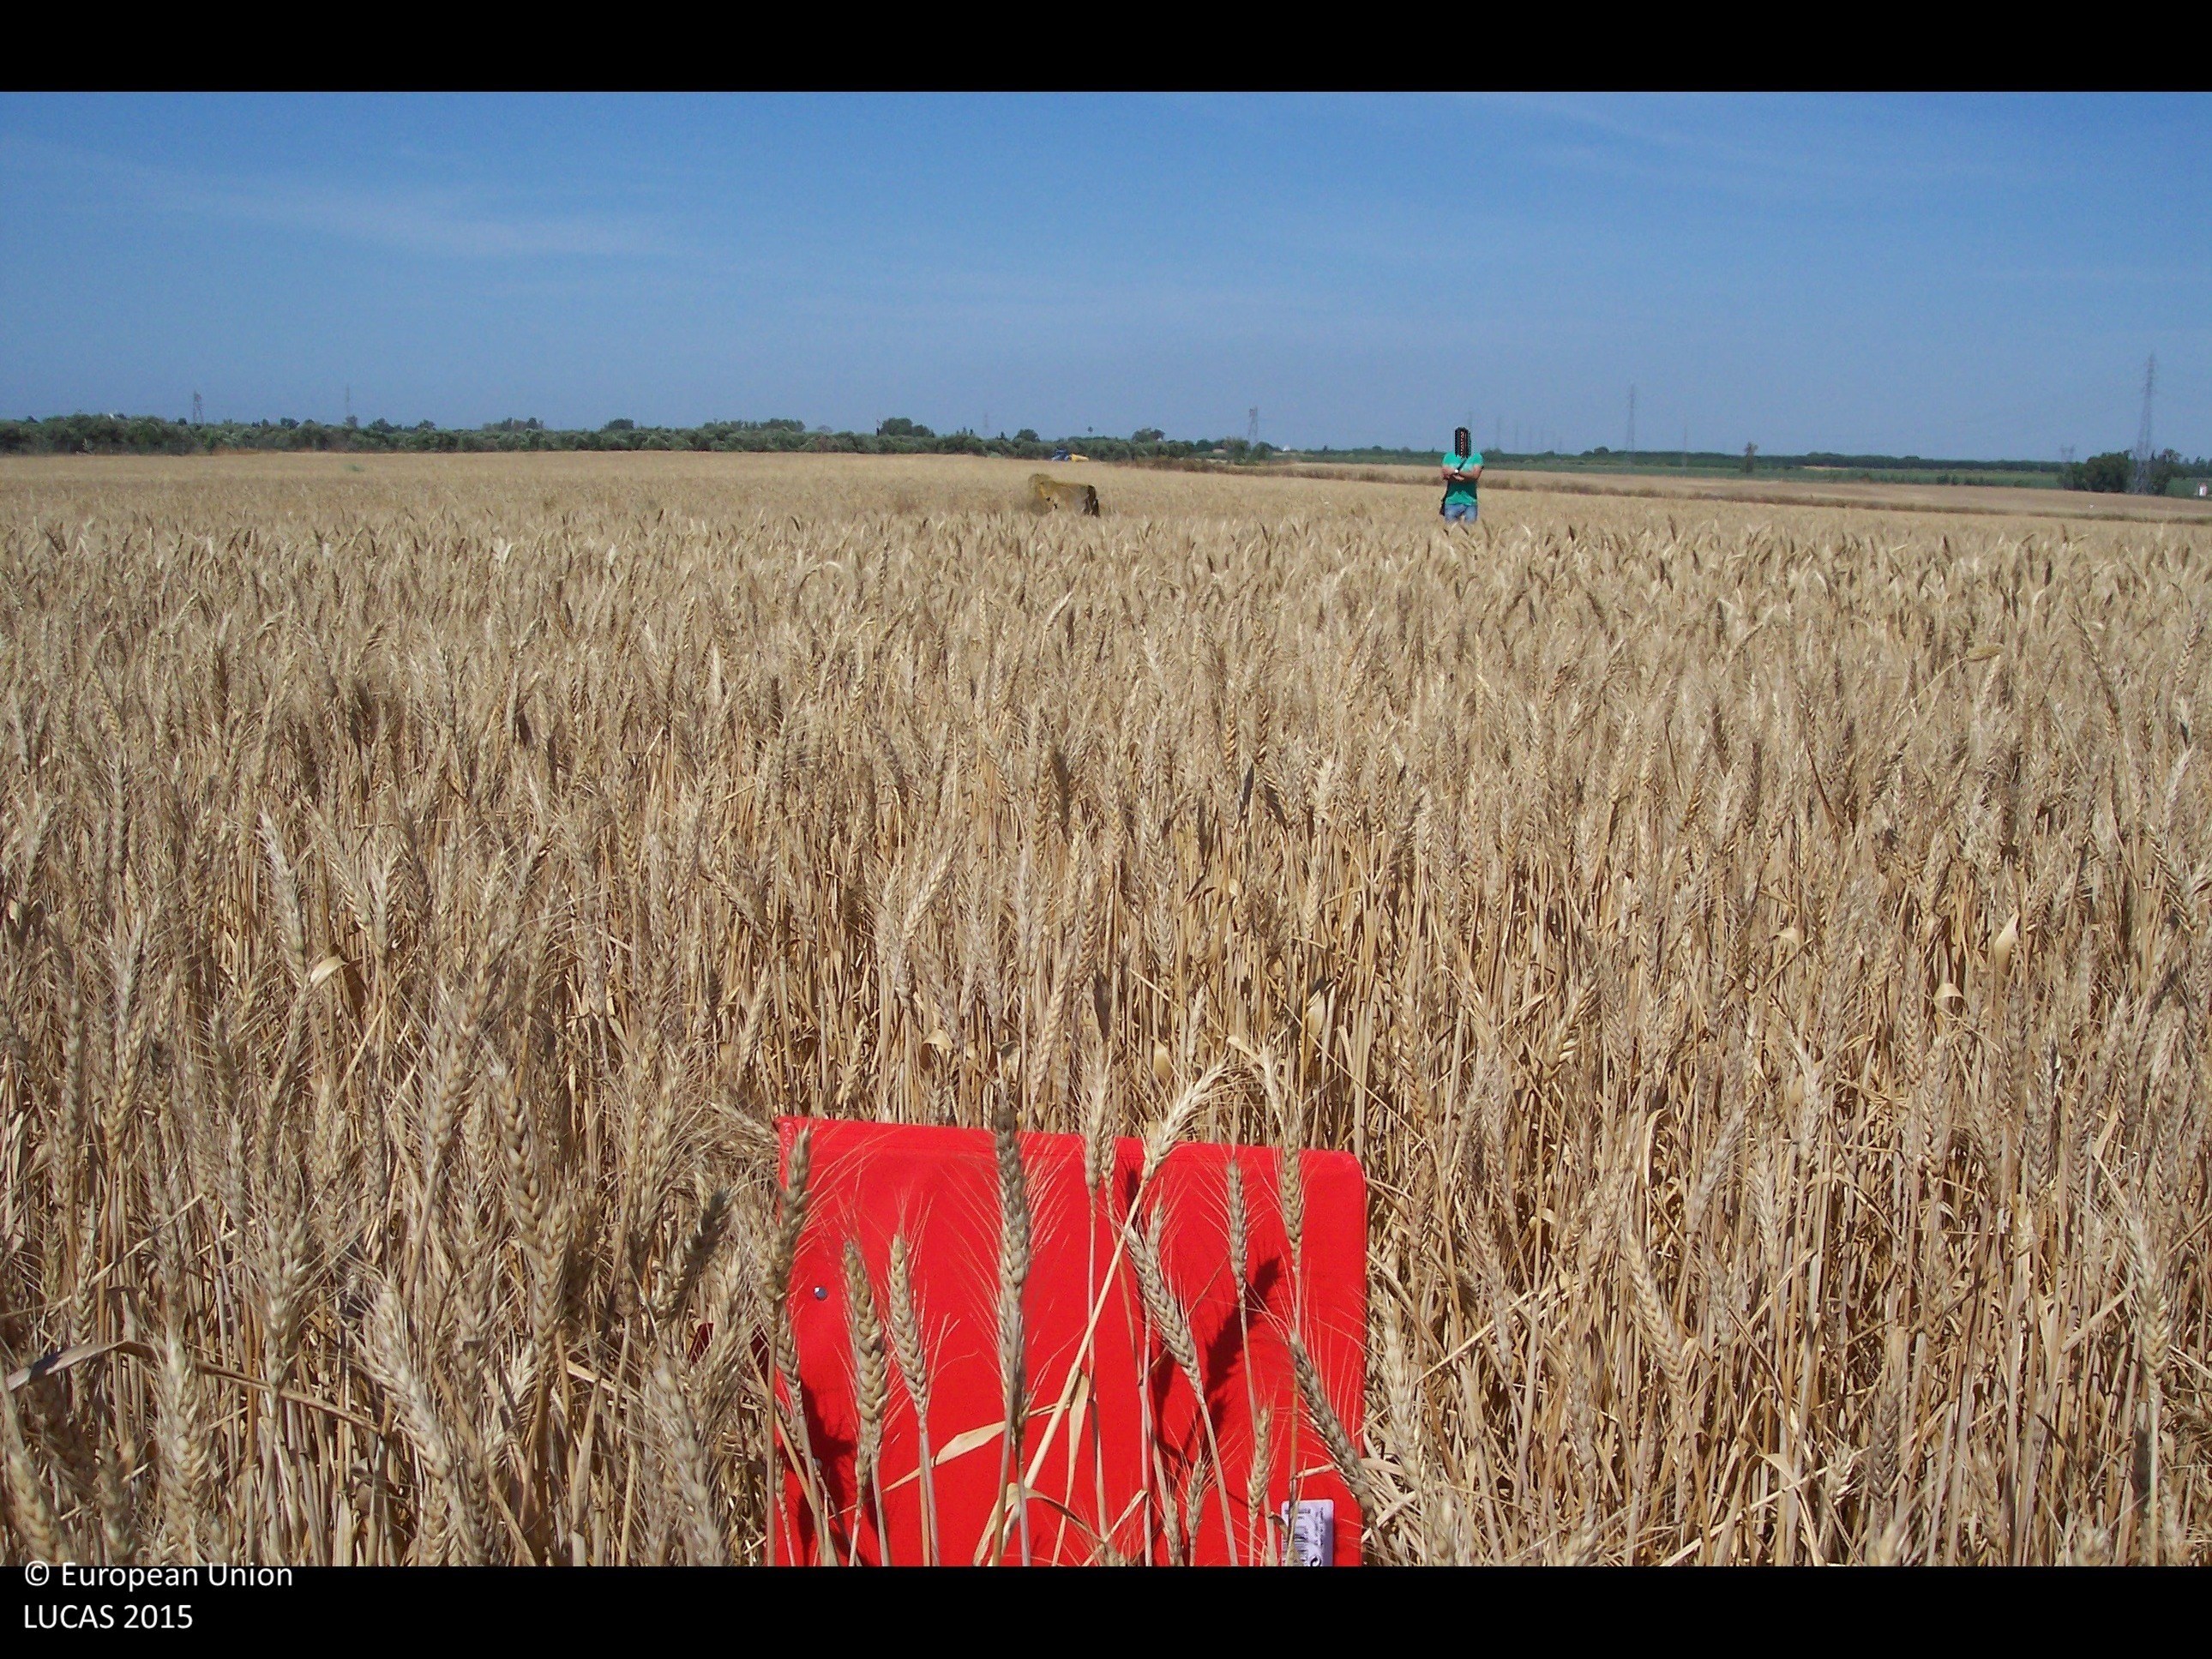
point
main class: Cropland
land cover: Durum wheat
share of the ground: > 75 %
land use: Agriculture (excluding fallow land and kitchen gardens)
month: May
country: ES
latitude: 37.2339
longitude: -5.8781
